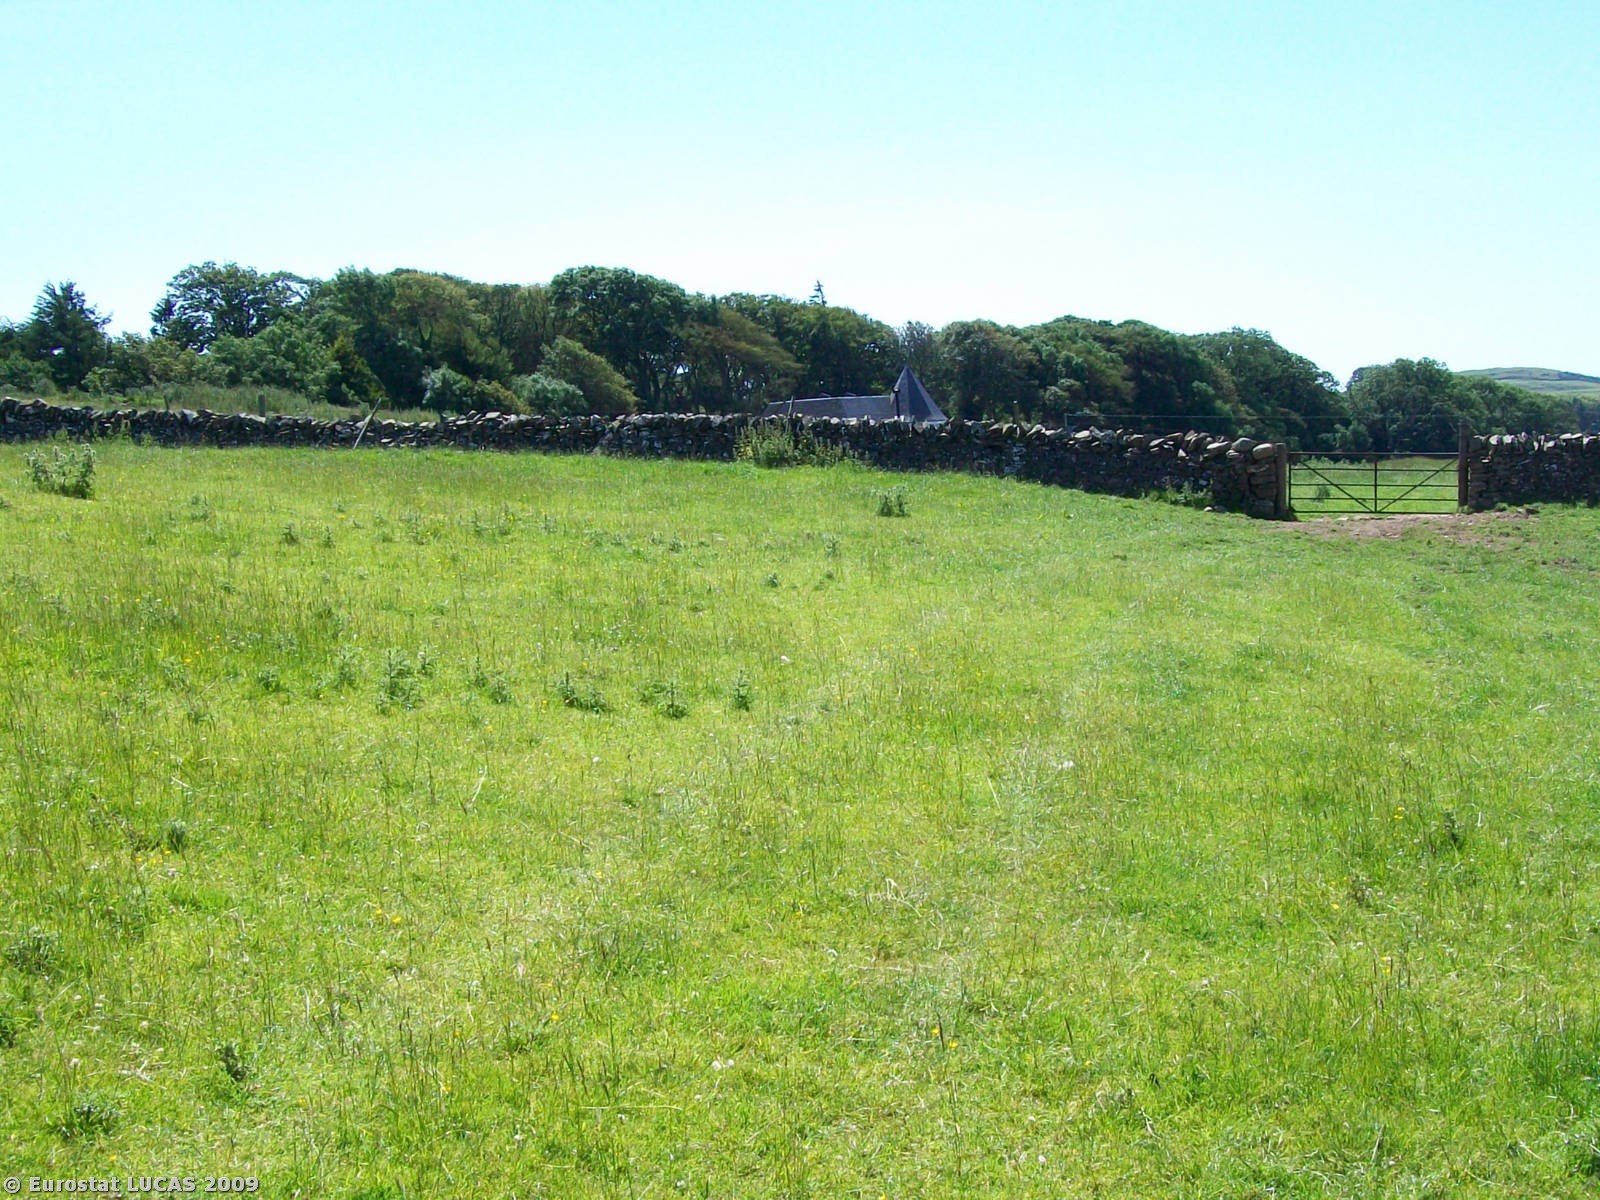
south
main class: Grassland
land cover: Grassland without tree/shrub cover
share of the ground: > 75 %
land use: Agriculture (excluding fallow land and kitchen gardens)
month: June
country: GB
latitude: 54.7994
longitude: -4.1091
